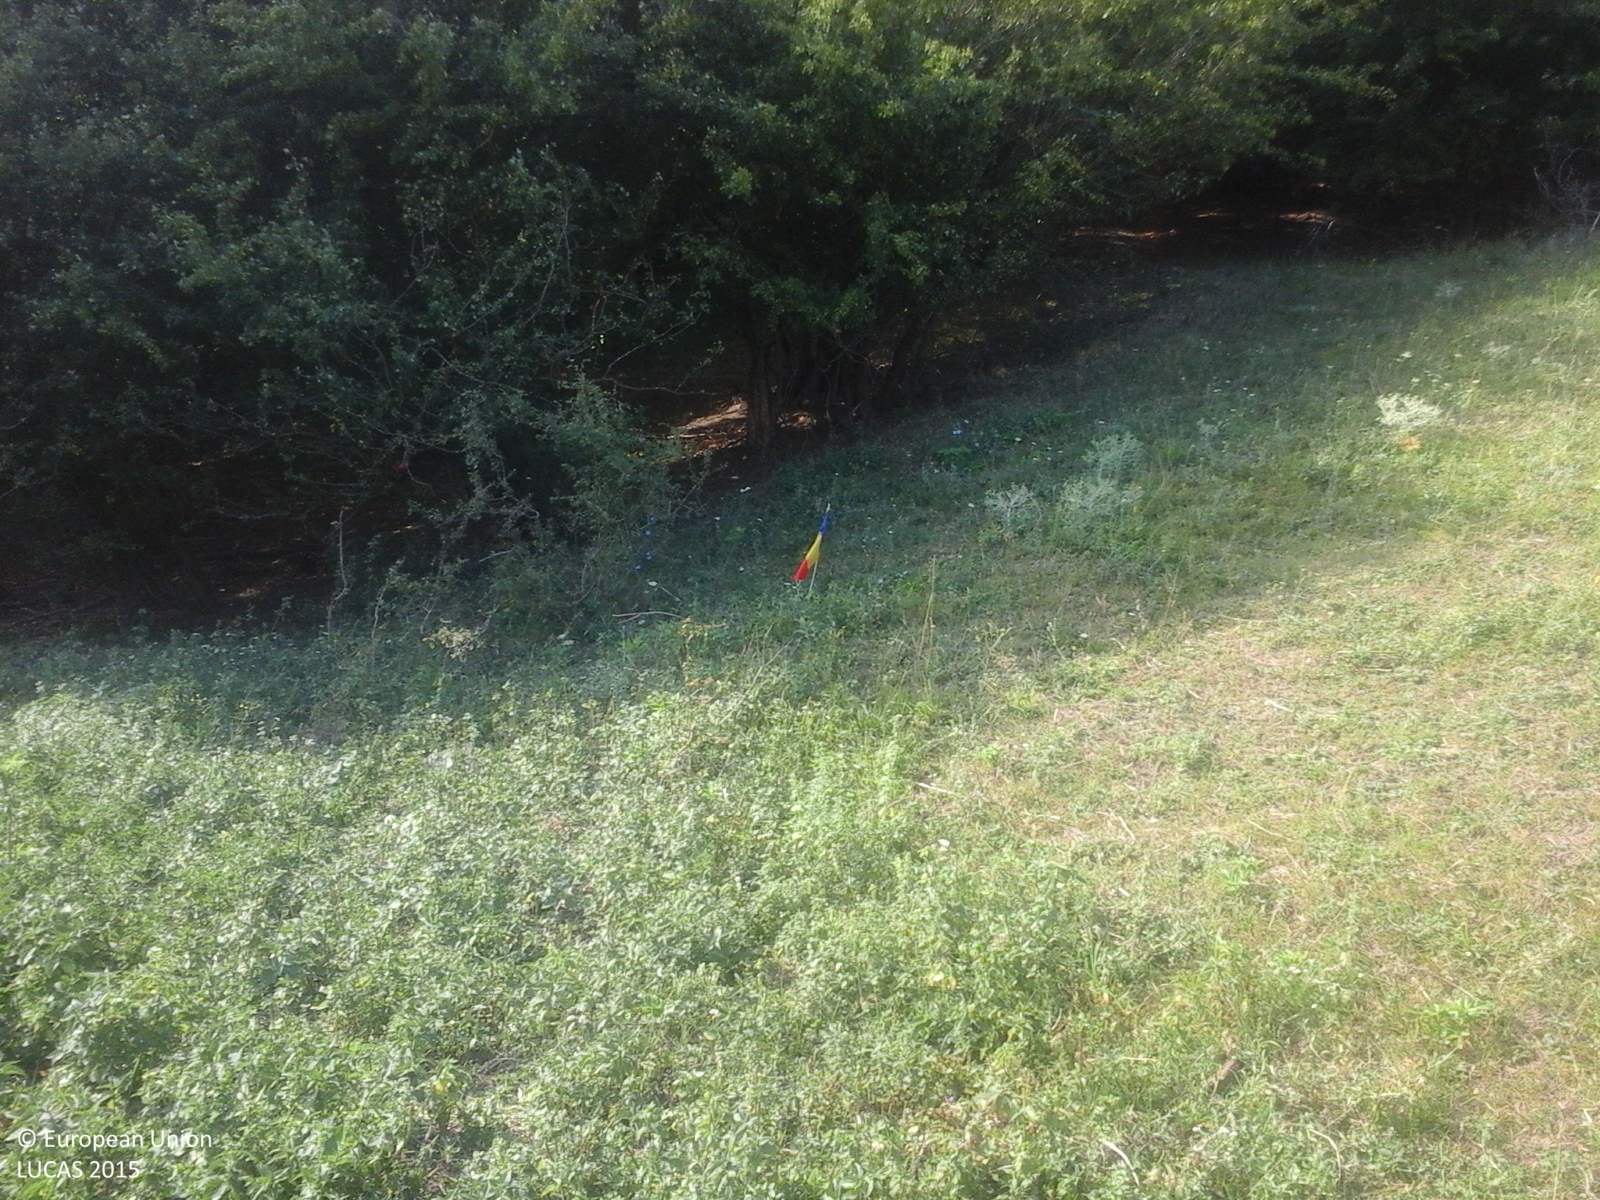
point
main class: Grassland
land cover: Grassland with sparse tree/shrub cover
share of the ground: > 75 %
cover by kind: herbaceous plants 85 %, shrubs 10 %, broadleaved forest trees 5 %
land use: Agriculture (excluding fallow land and kitchen gardens)
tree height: < 5 m
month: July
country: RO
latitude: 46.6053
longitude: 27.9462
